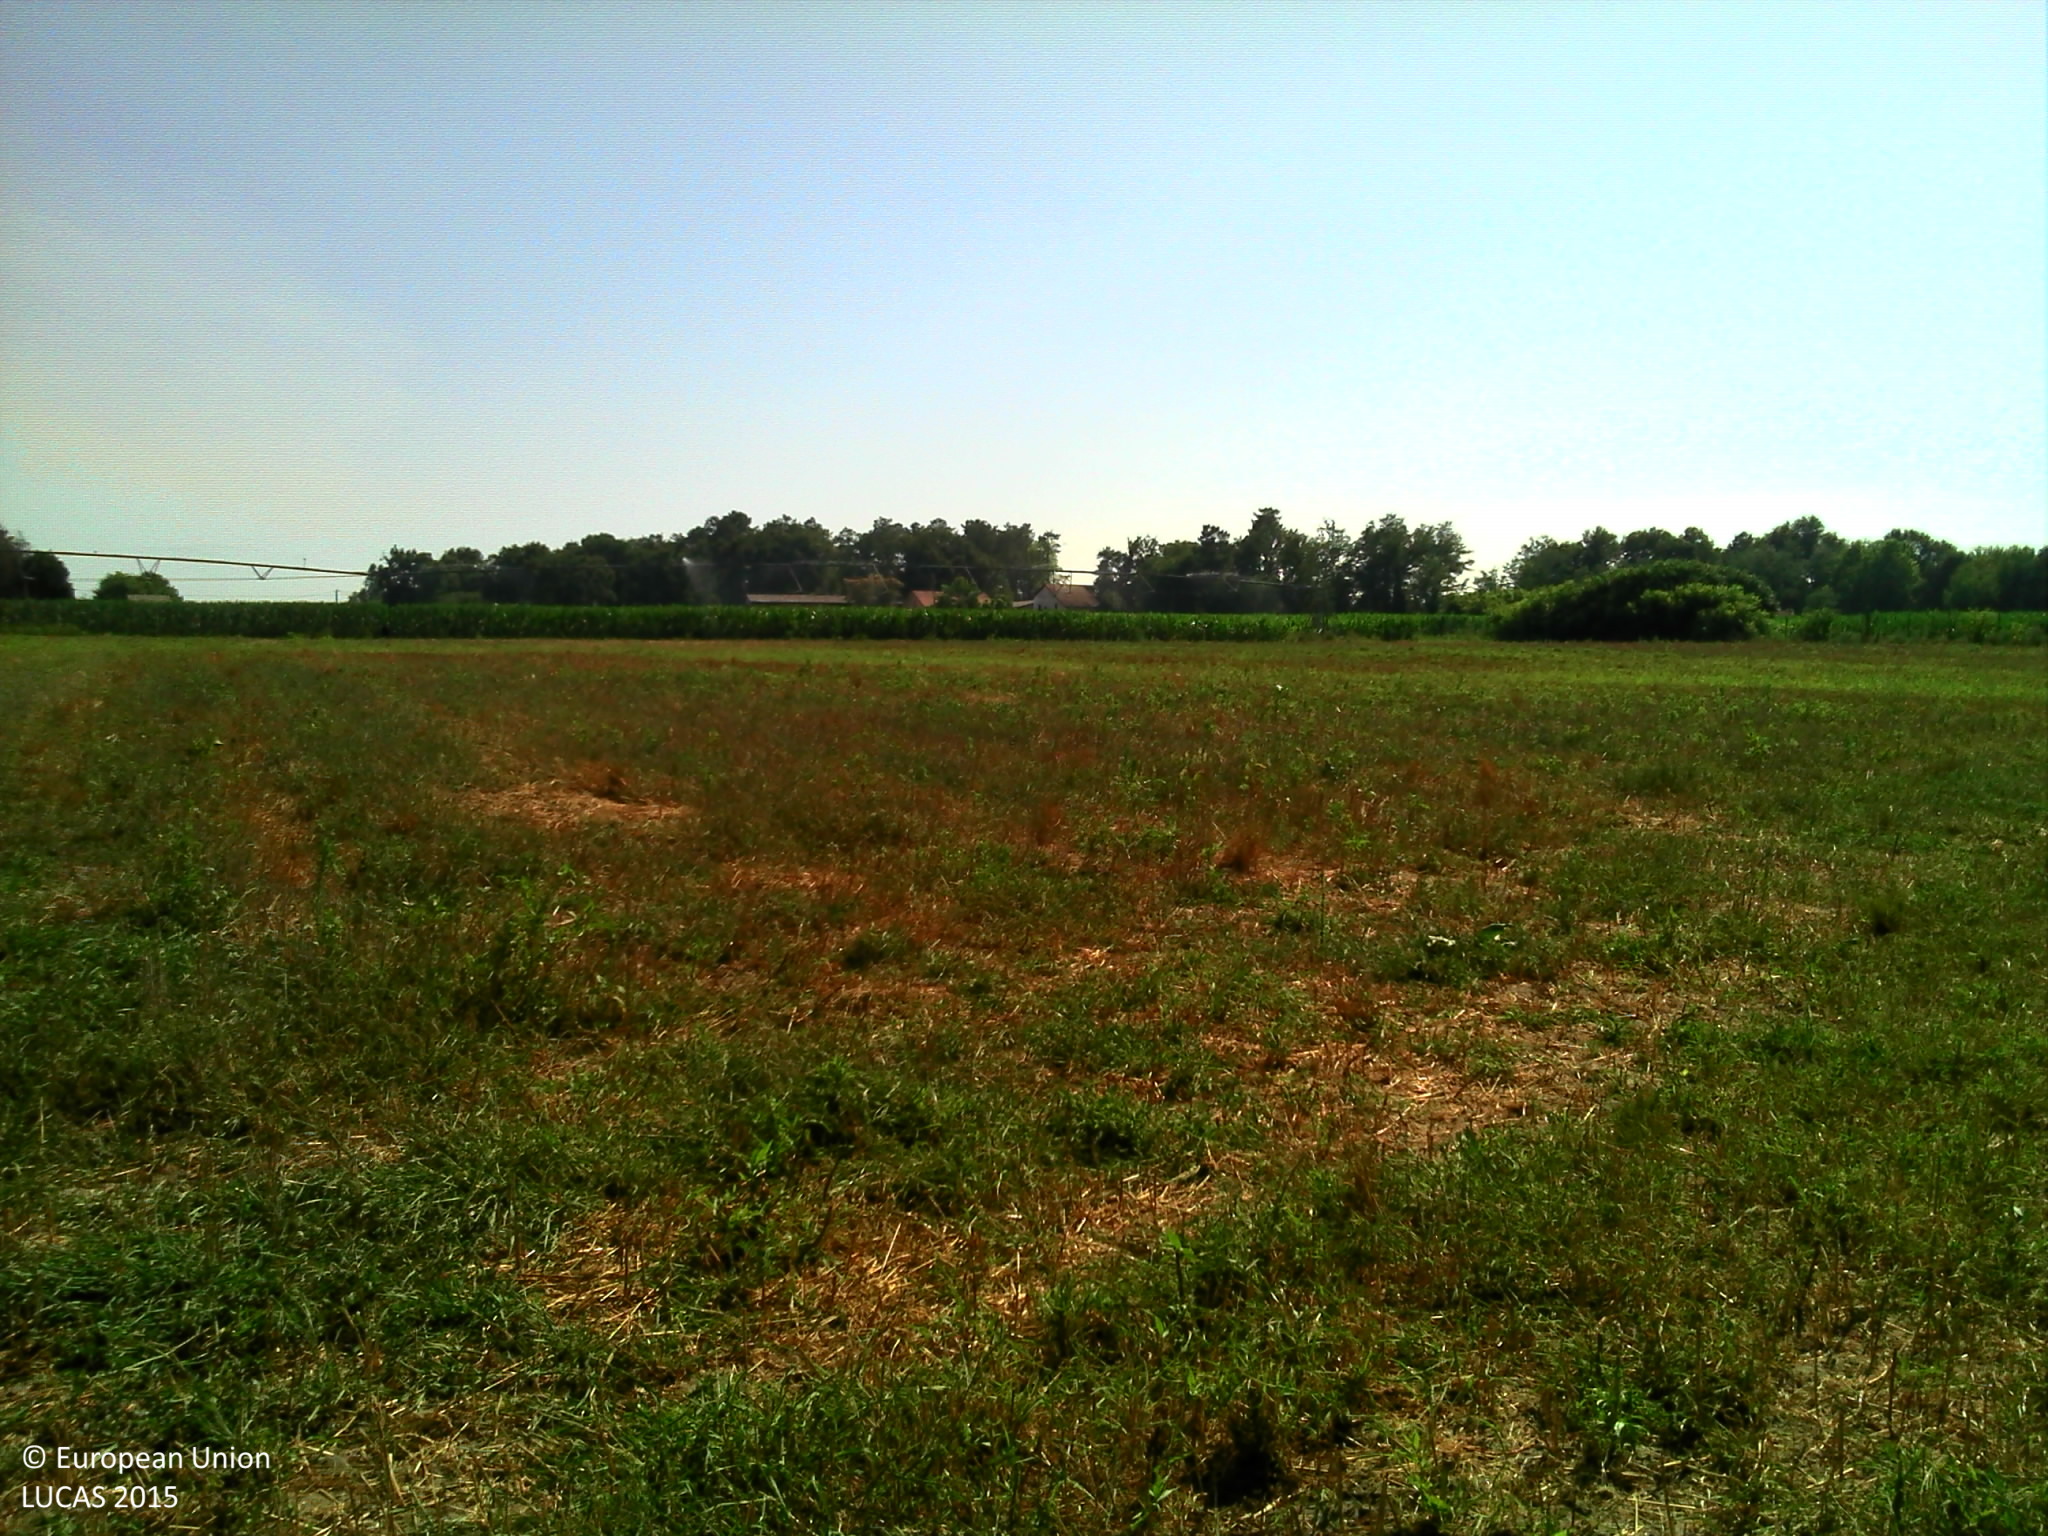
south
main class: Cropland
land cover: Temporary grasslands
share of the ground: > 75 %
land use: Agriculture (excluding fallow land and kitchen gardens)
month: July
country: FR
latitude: 43.6936
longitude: -1.1457
